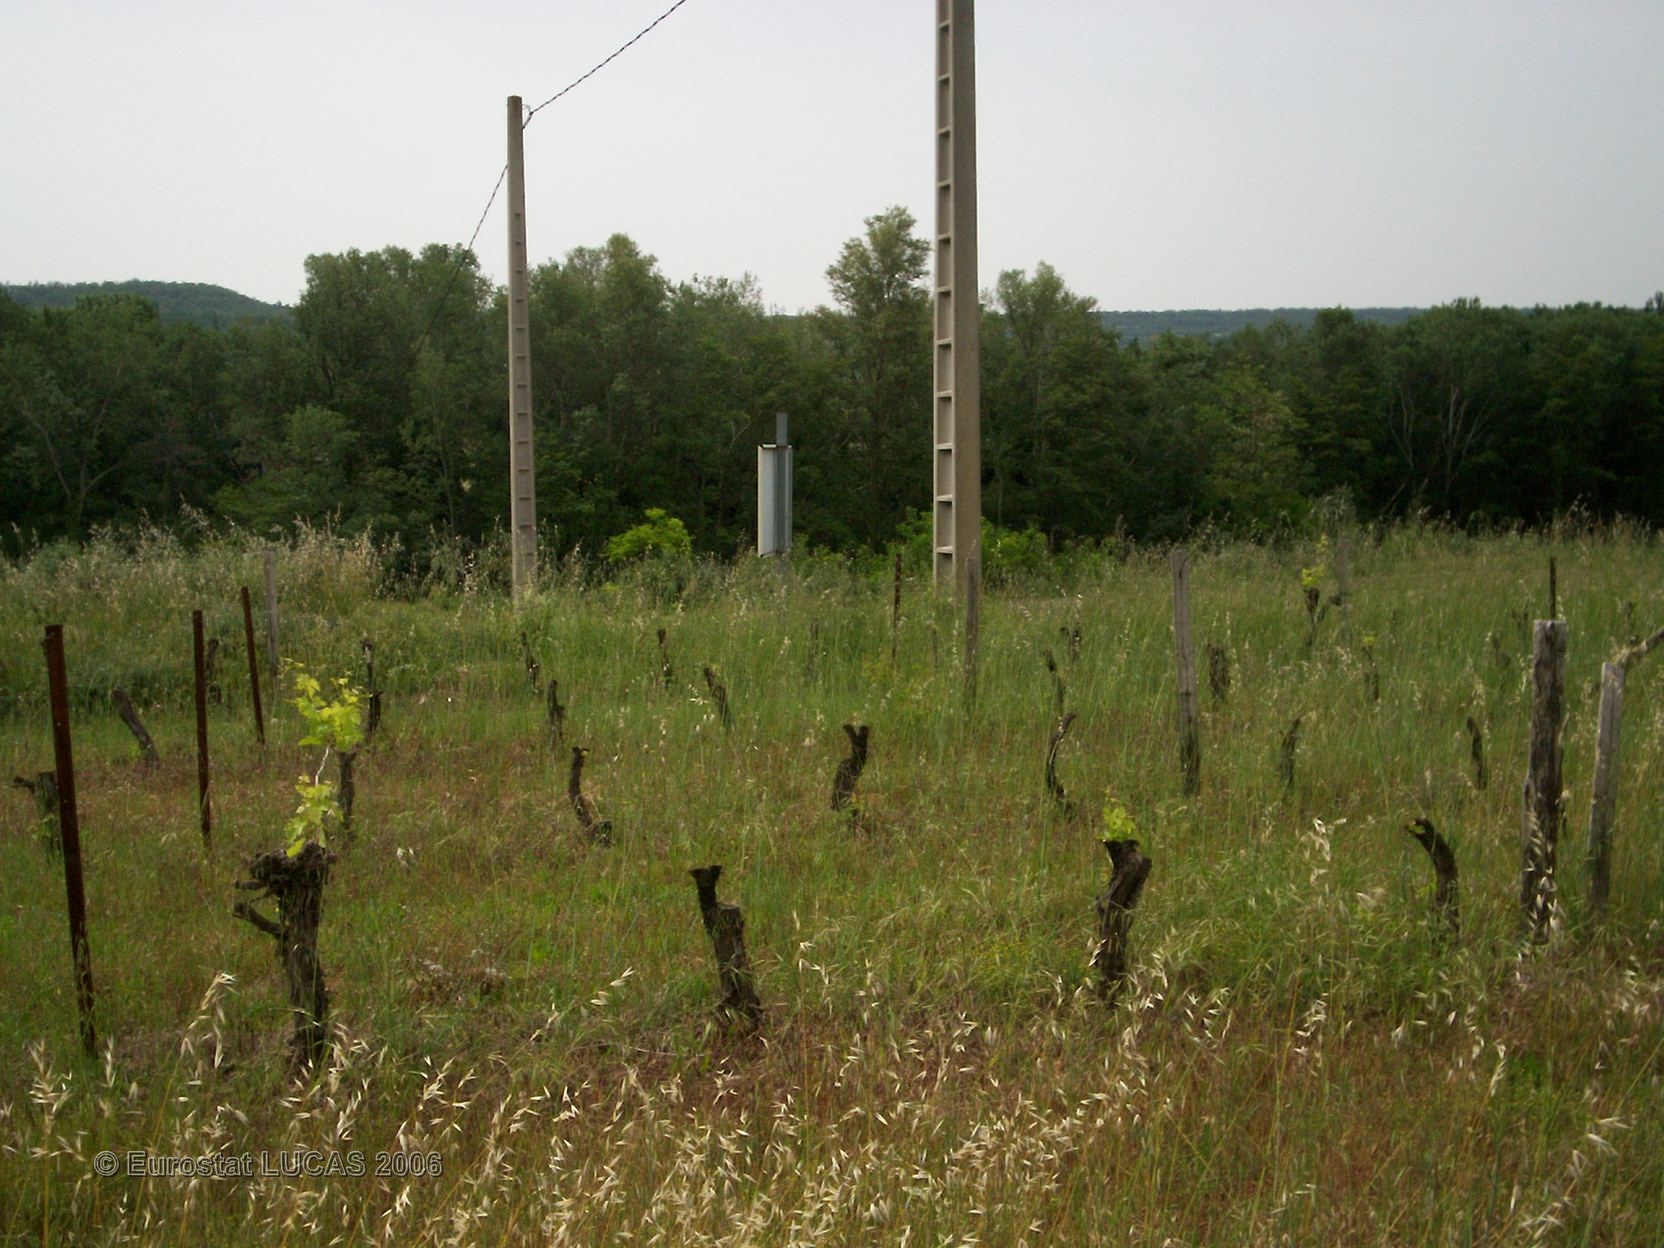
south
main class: Cropland
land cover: Vineyards
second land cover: Grassland with sparse tree/shrub cover
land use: Agriculture (excluding fallow land and kitchen gardens)
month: May
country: FR
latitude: 44.4212
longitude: 4.8450
